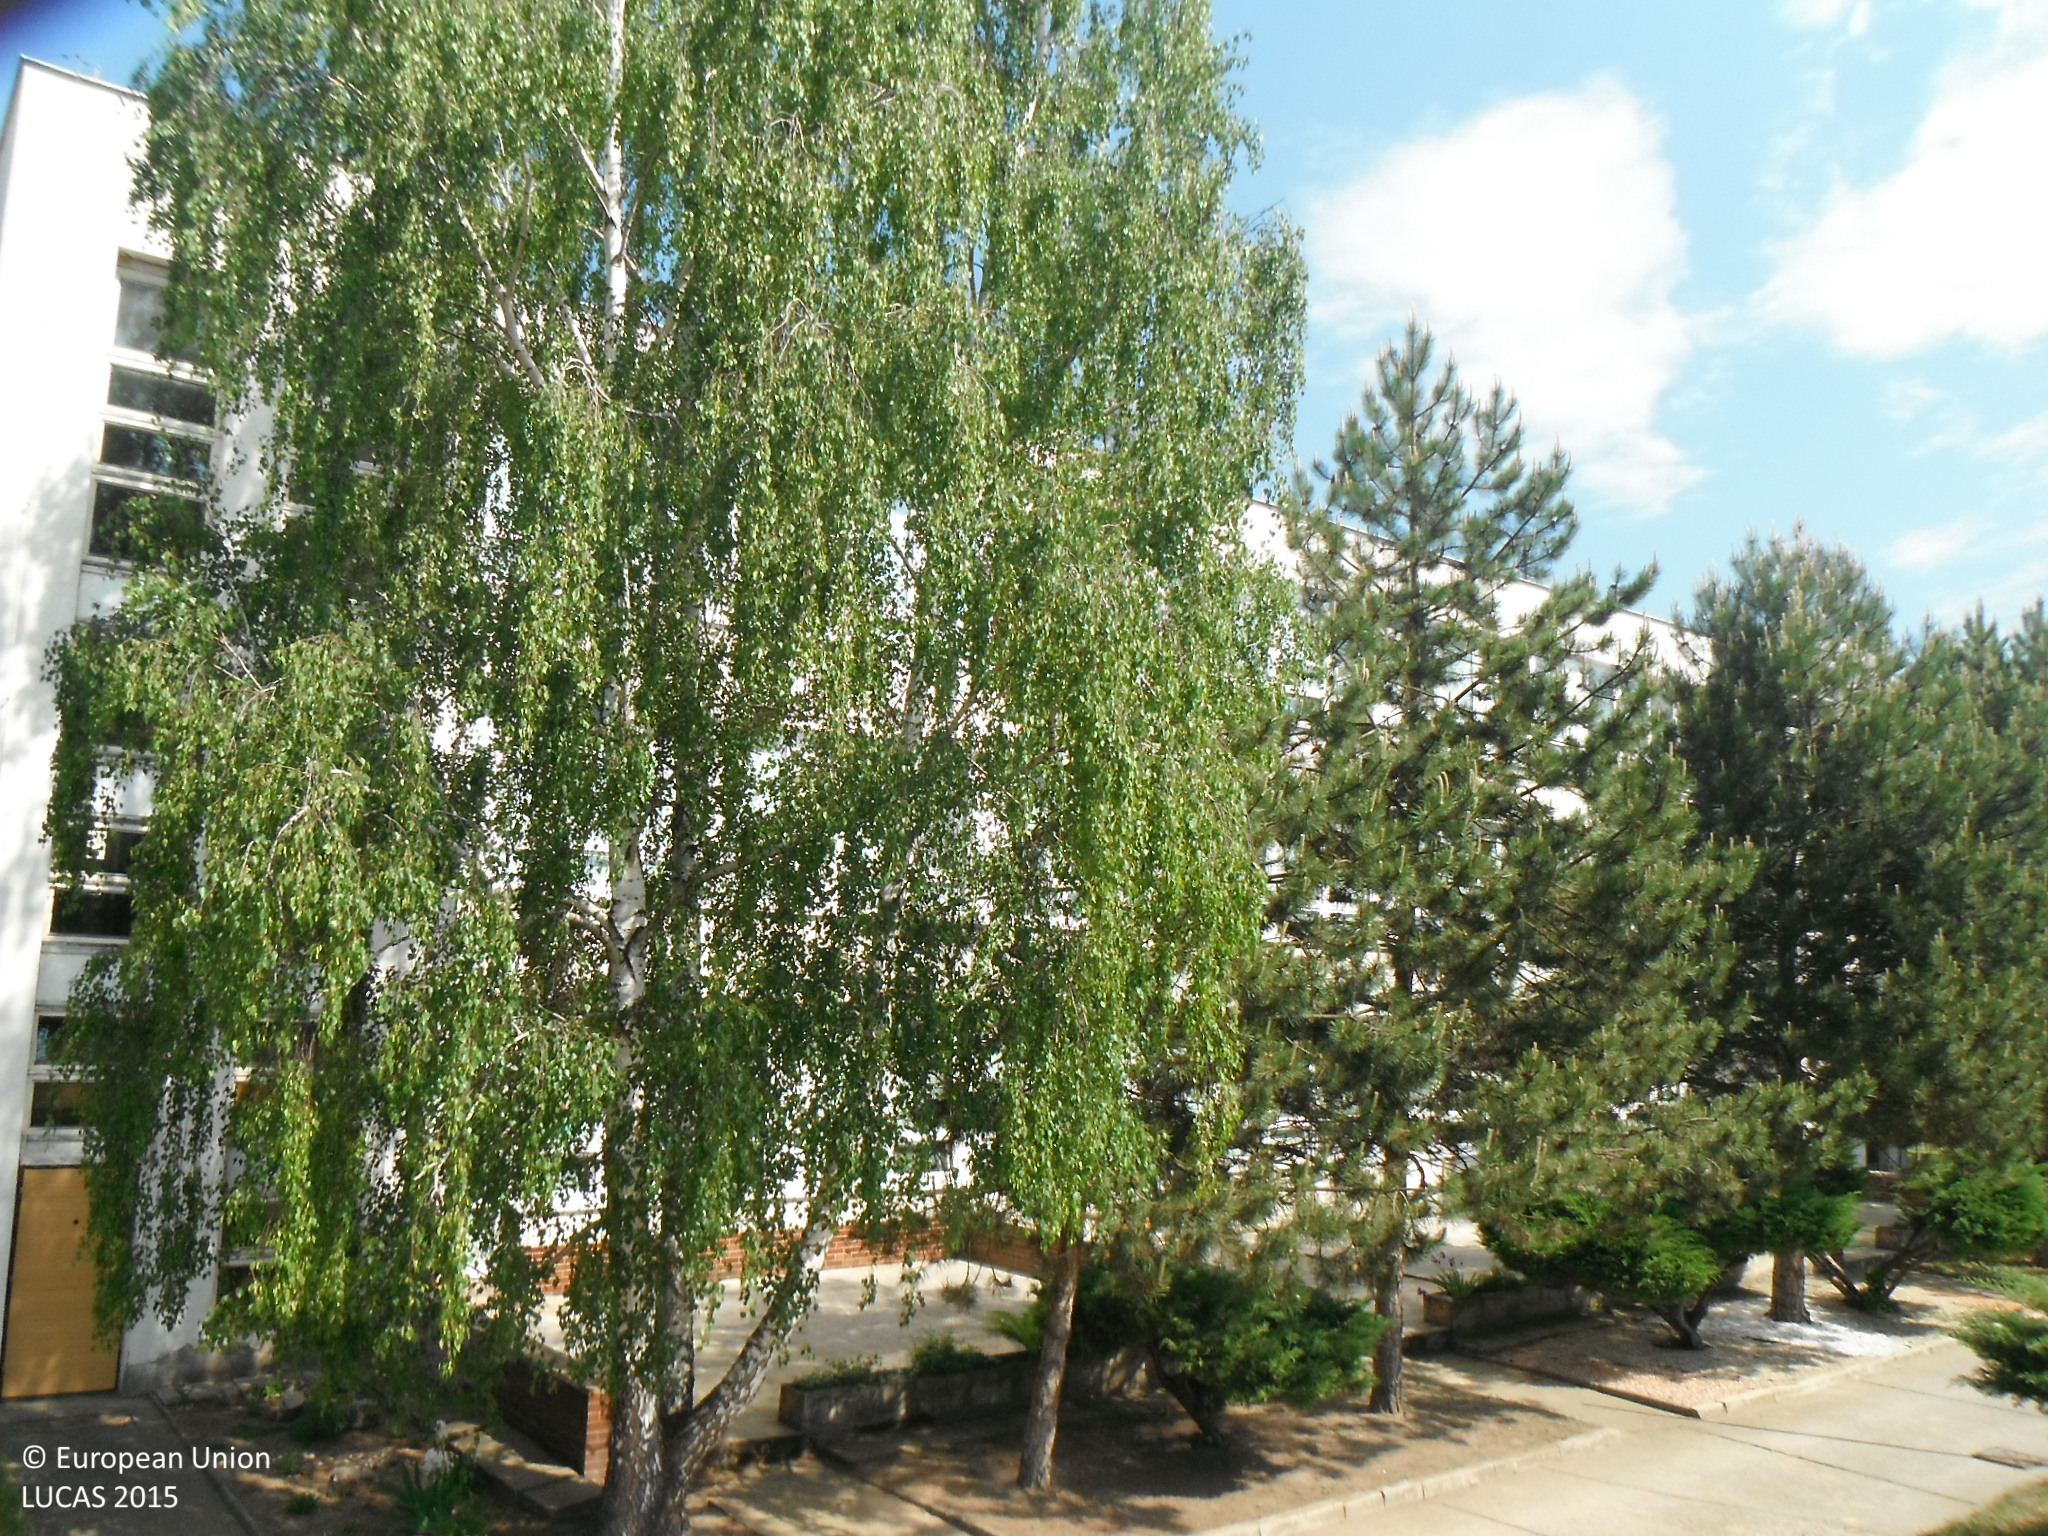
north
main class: Grassland
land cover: Grassland with sparse tree/shrub cover
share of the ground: > 75 %
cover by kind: herbaceous plants 95 %, broadleaved forest trees 5 %
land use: Community services
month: May
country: SK
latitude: 48.5062
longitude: 17.0060
